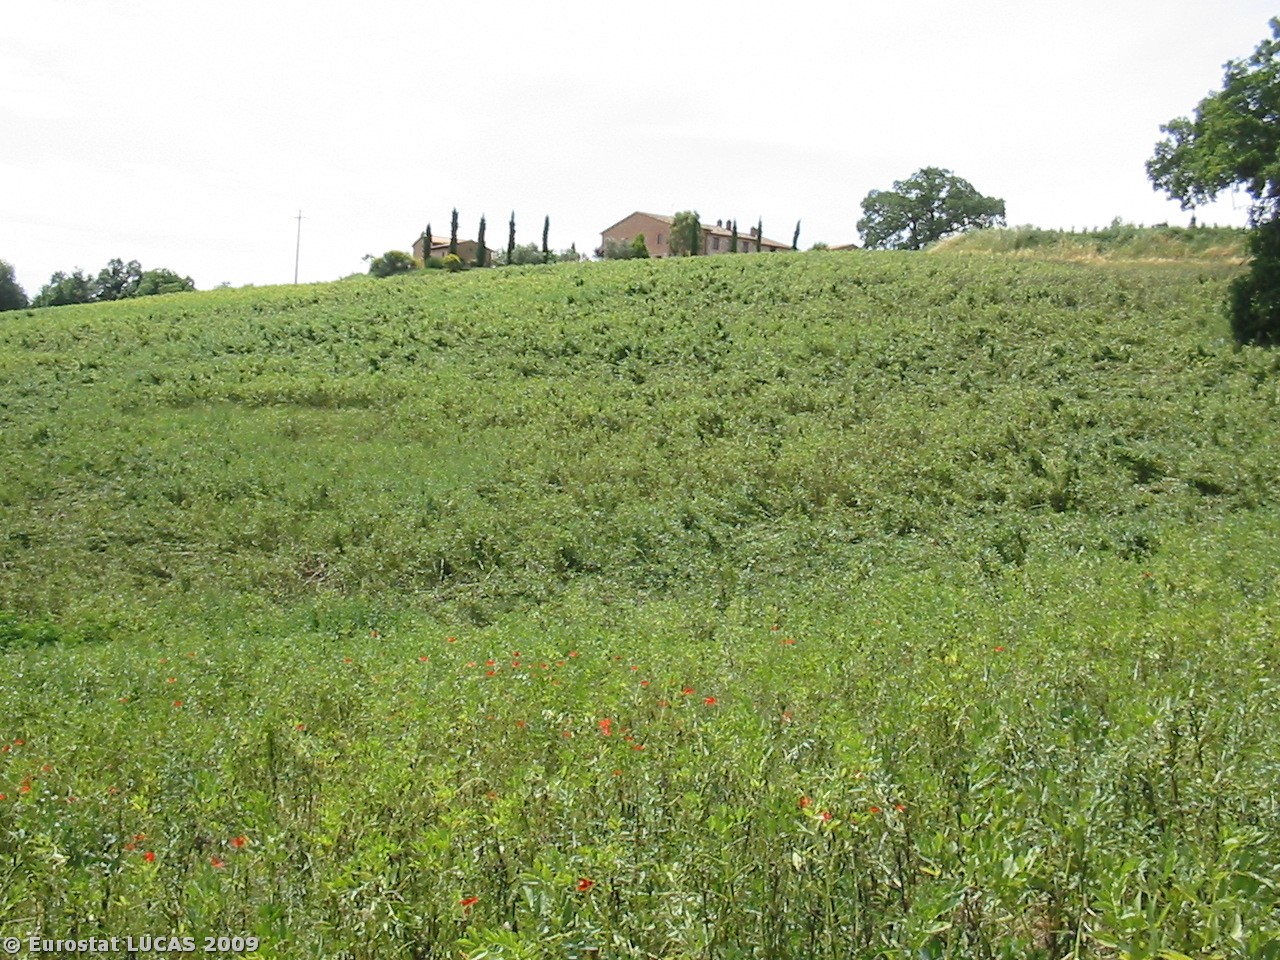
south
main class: Cropland
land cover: Dry pulses
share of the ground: > 75 %
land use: Agriculture (excluding fallow land and kitchen gardens)
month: June
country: IT
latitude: 42.9586
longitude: 12.0410
